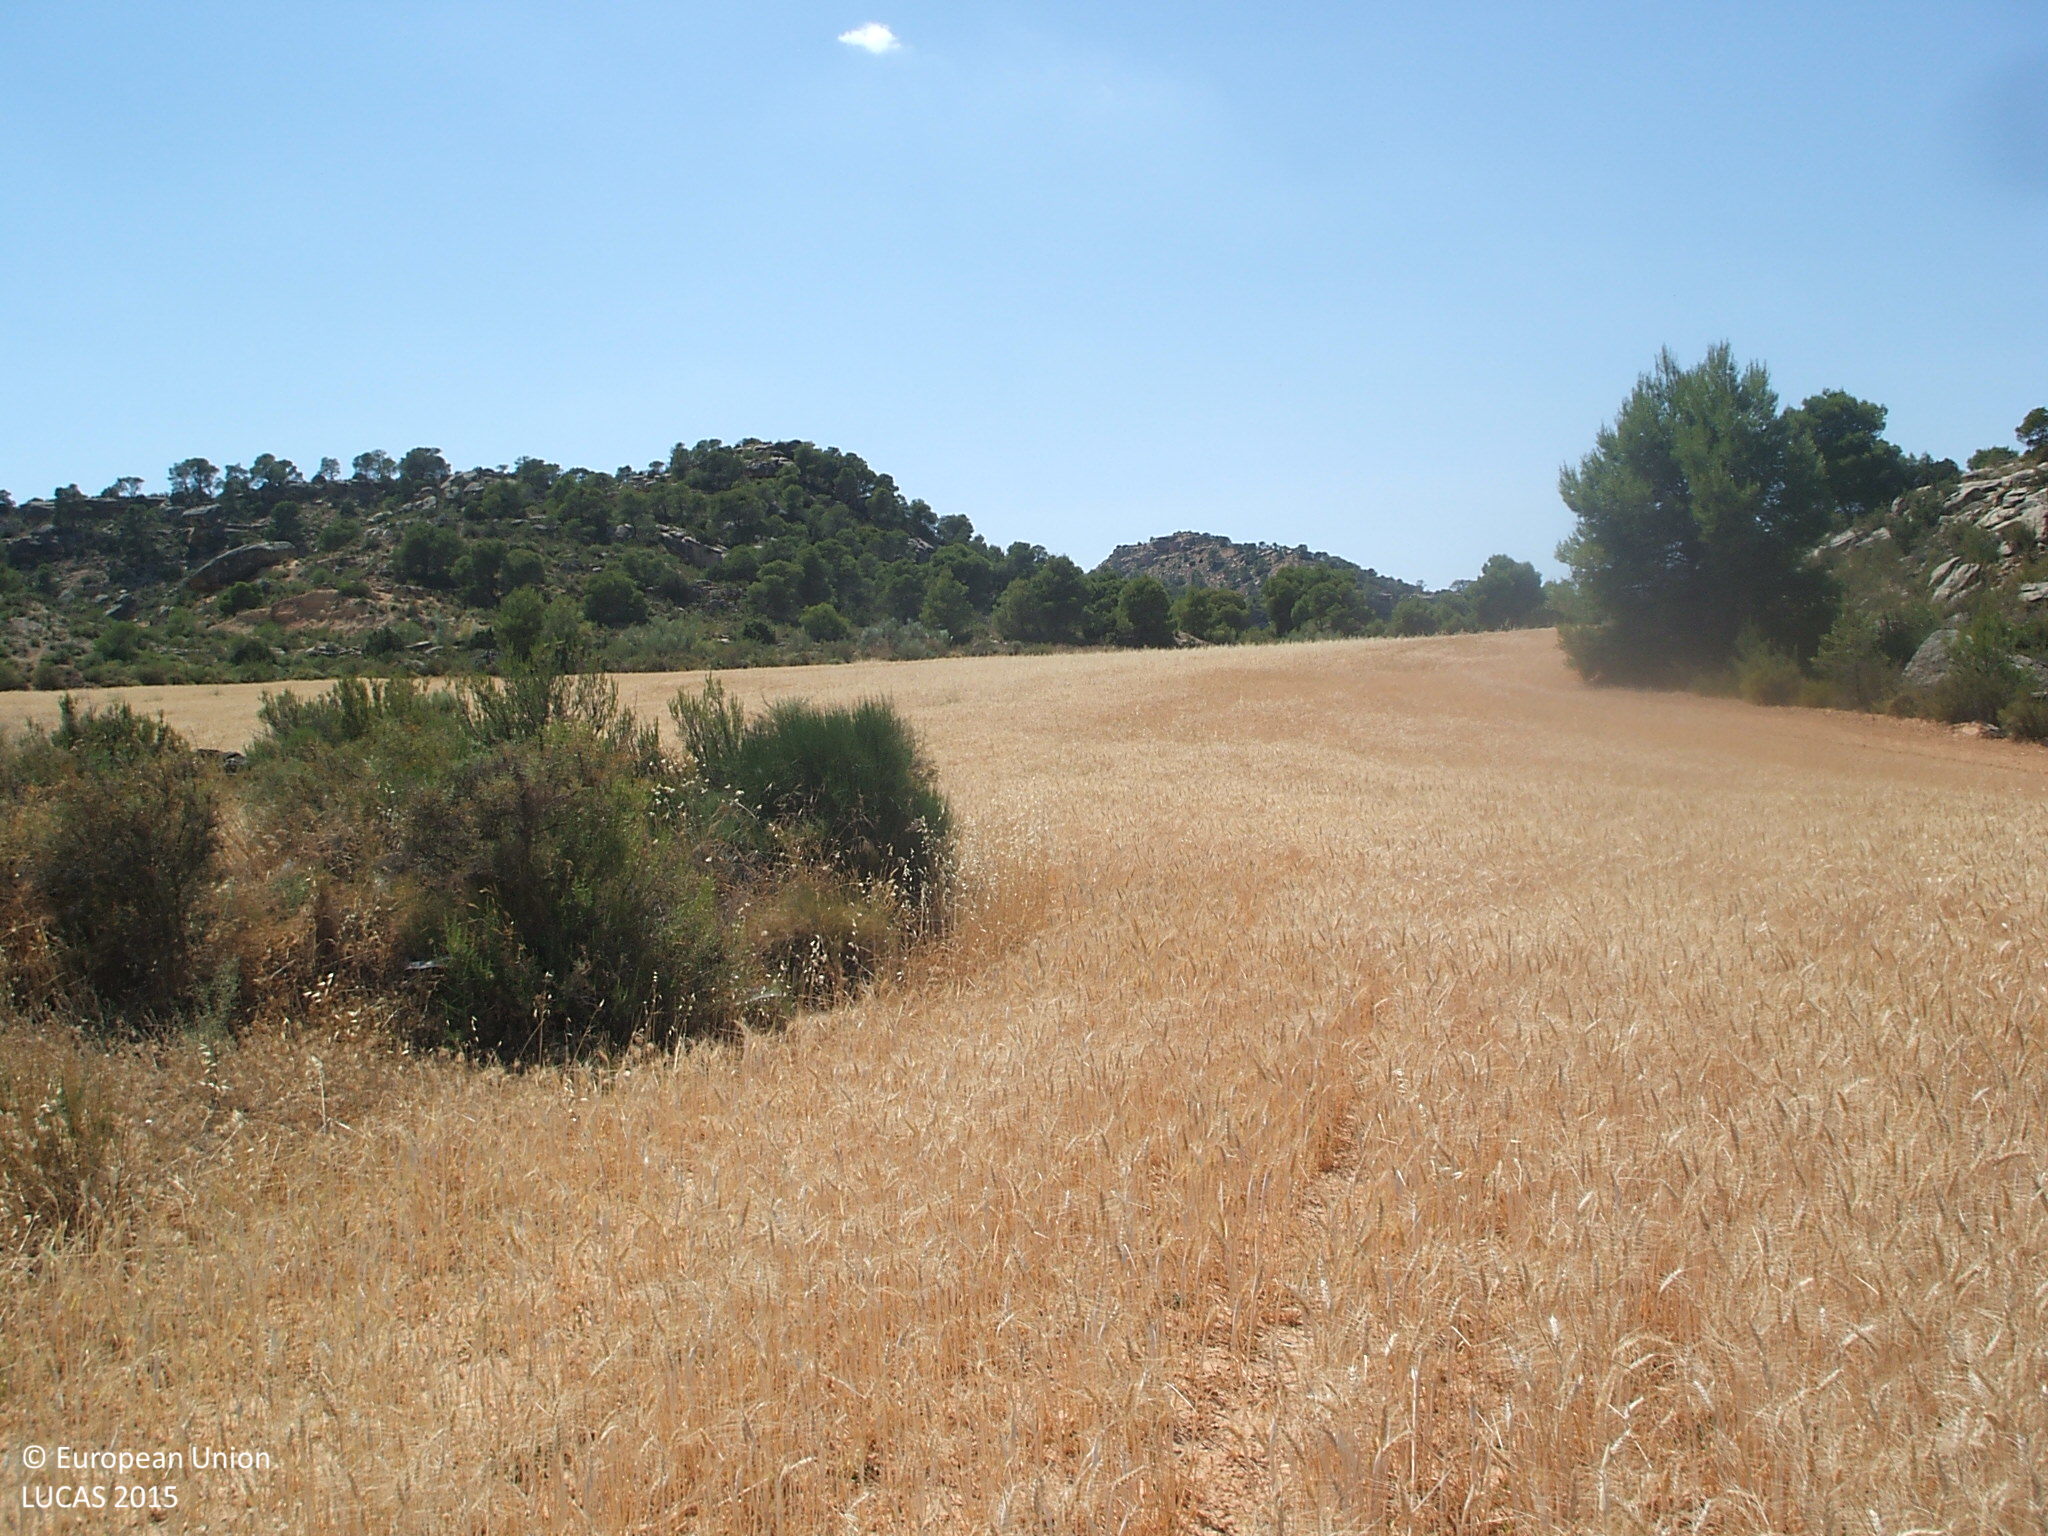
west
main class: Cropland
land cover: Common wheat
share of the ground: > 75 %
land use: Agriculture (excluding fallow land and kitchen gardens)
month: June
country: ES
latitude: 41.0955
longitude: -0.0718
